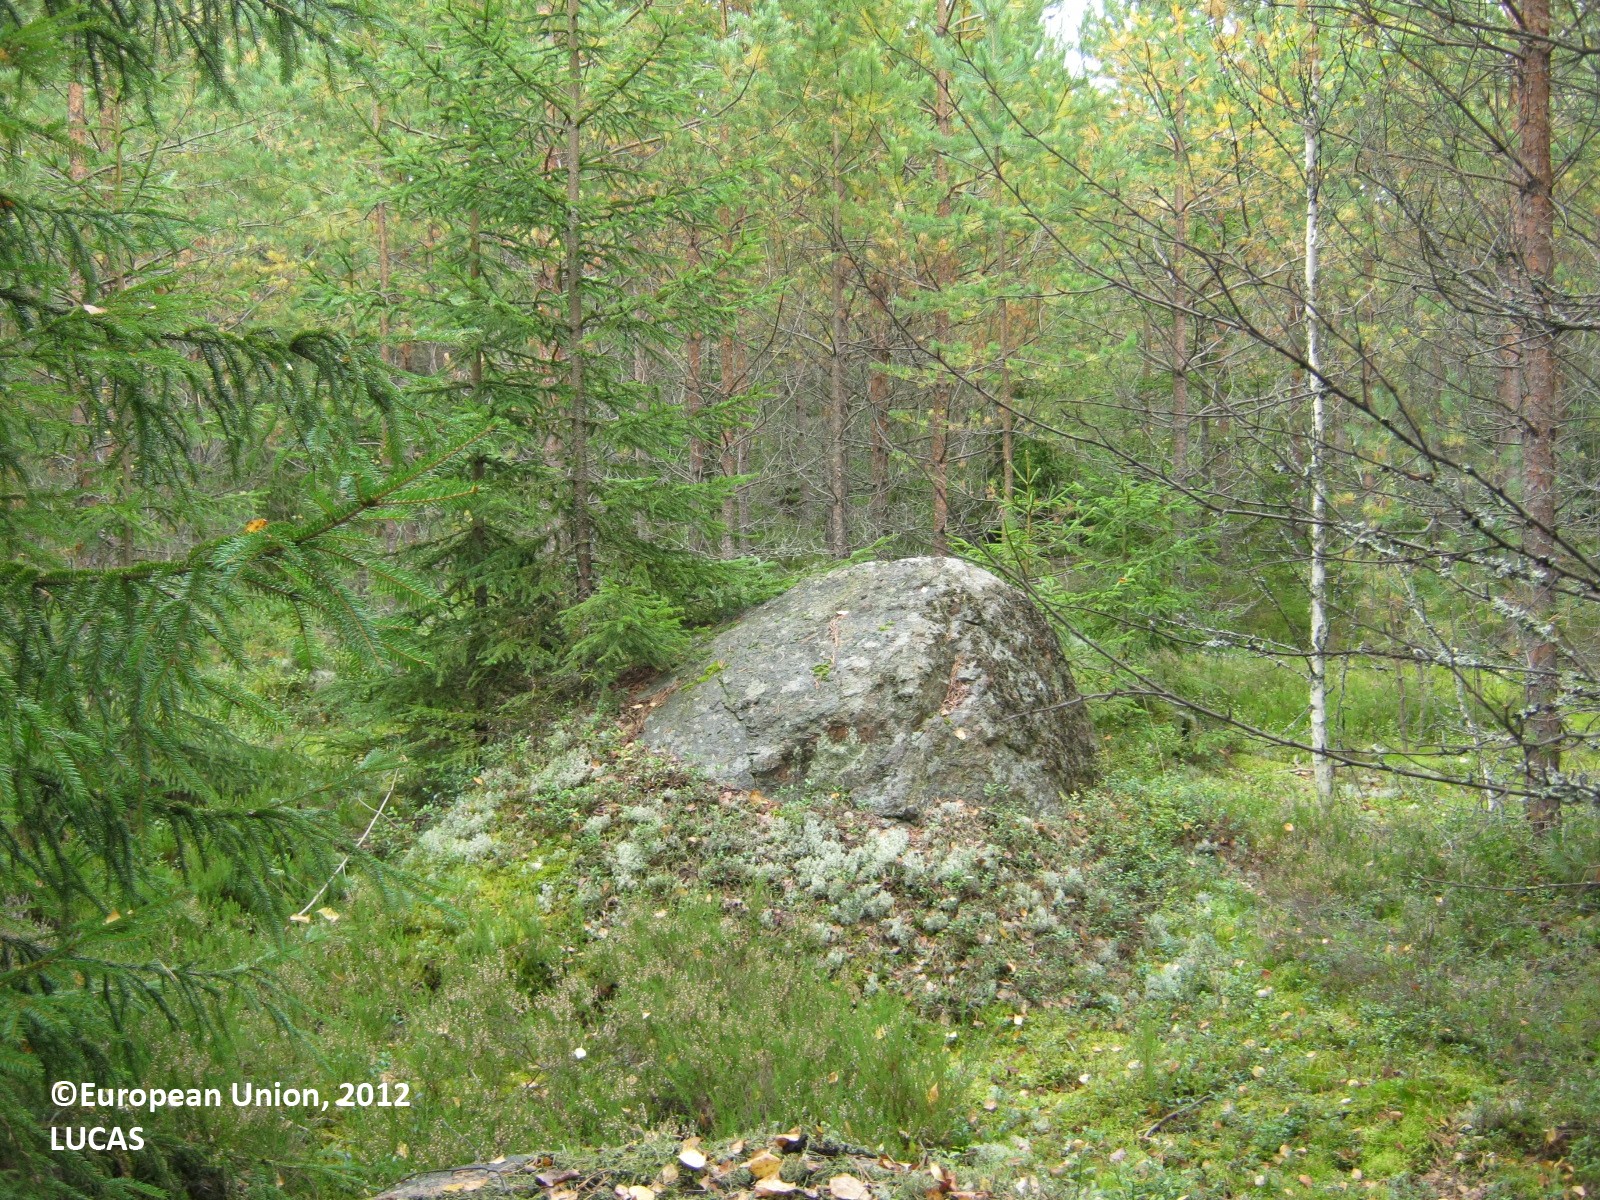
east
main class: Woodland
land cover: Pine dominated mixed woodland
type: boreal forest
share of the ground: > 75 %
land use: Forestry
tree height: > 5 m
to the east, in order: Pine dominated mixed woodland; Other mixed woodland; Tracks; Pine dominated mixed woodland
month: September
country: FI
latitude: 60.5810
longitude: 27.5818
